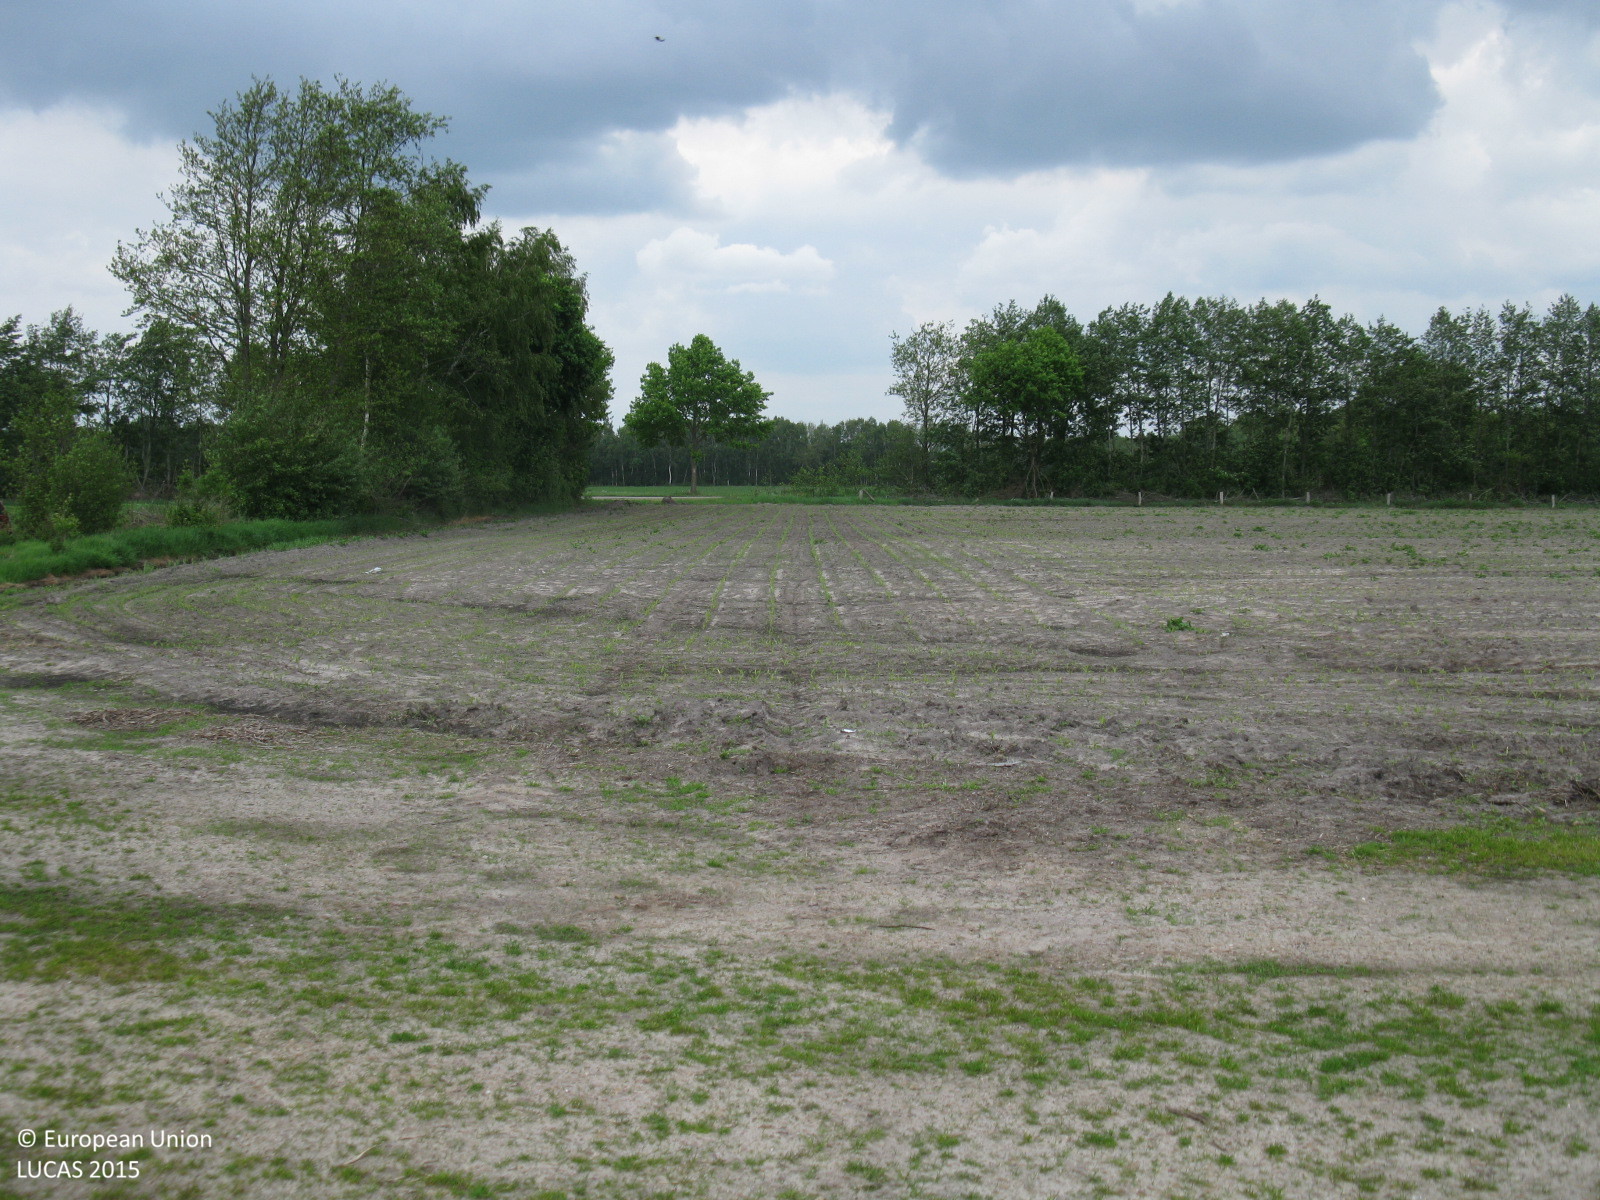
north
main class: Cropland
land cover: Maize
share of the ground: < 10 %
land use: Agriculture (excluding fallow land and kitchen gardens)
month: May
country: DE
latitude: 52.9789
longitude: 7.4240
